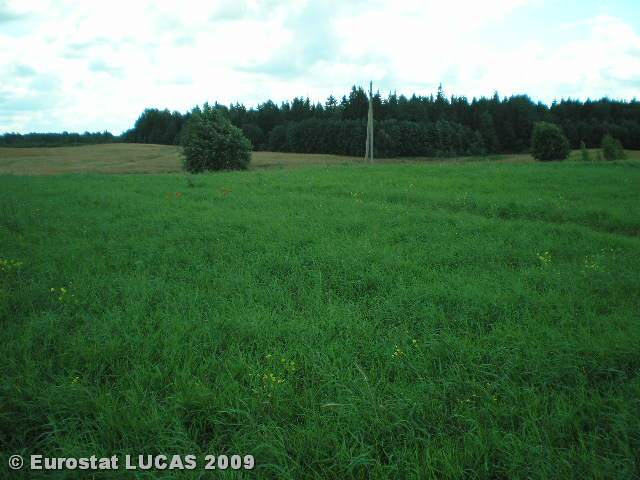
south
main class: Grassland
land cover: Grassland without tree/shrub cover
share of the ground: > 75 %
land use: Agriculture (excluding fallow land and kitchen gardens)
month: July
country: LT
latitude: 54.9025
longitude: 25.3912
